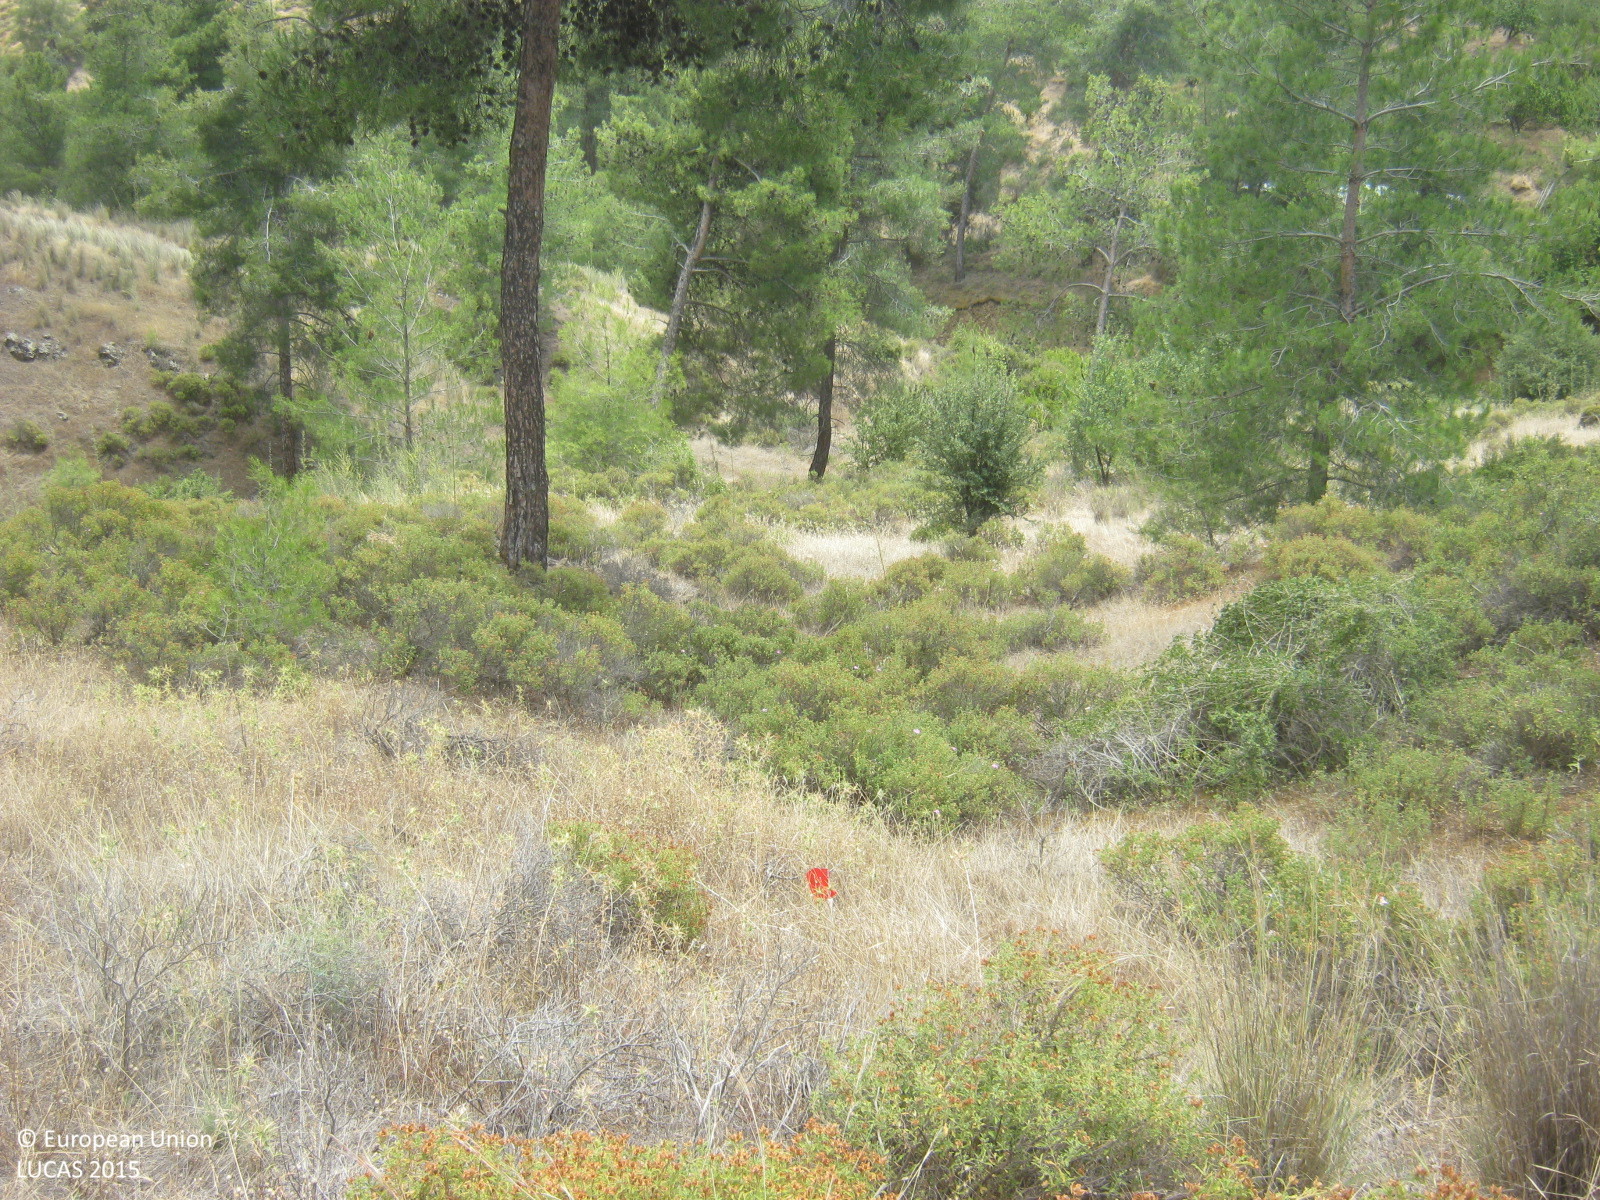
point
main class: Woodland
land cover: Pine dominated coniferous woodland
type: coniferous forest of the mediterranean region
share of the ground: 10 - 25 %
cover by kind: shrubs 40 %, herbaceous plants 30 %, coniferous forest trees 25 %, unconsolidated bare surface 5 %
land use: Forestry
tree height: > 5 m
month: June
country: CY
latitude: 35.0505
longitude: 32.8762
